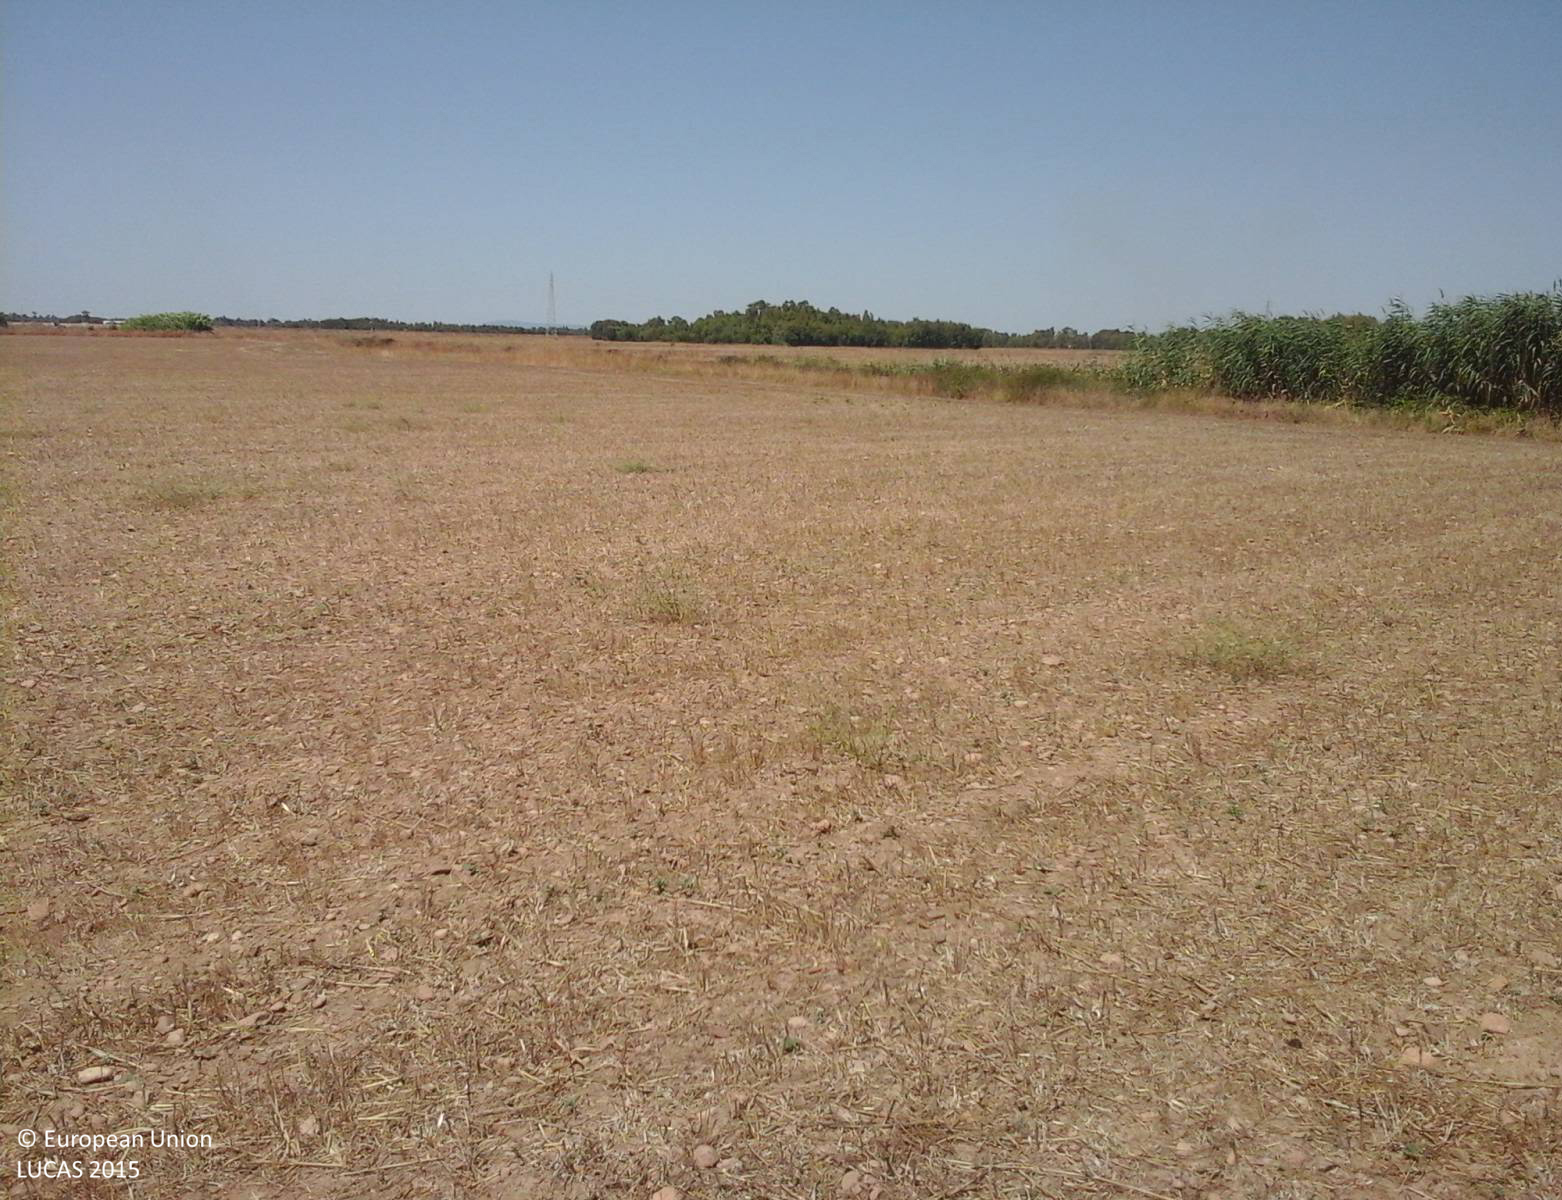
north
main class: Cropland
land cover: Mixed cereals for fodder
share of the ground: > 75 %
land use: Agriculture (excluding fallow land and kitchen gardens)
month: August
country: IT
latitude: 39.3737
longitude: 8.9039
